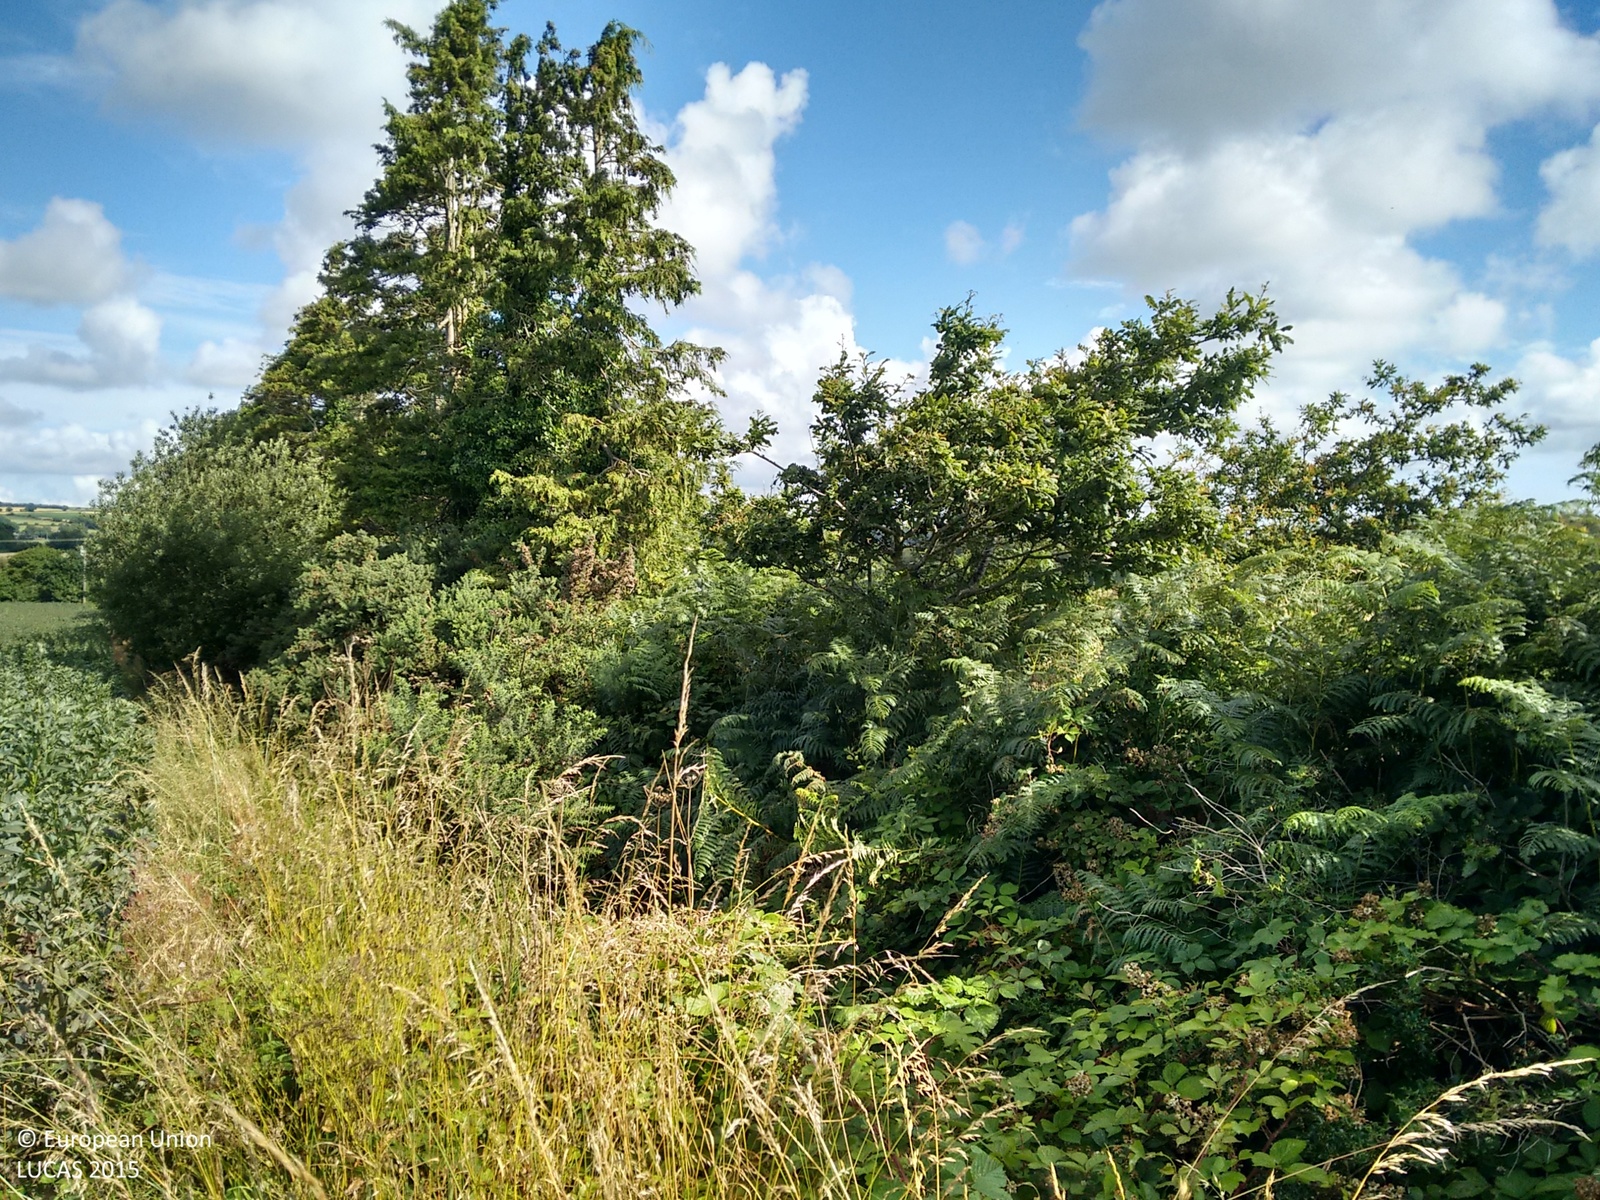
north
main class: Cropland
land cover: Dry pulses
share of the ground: > 75 %
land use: Agriculture (excluding fallow land and kitchen gardens)
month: August
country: IE
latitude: 52.5360
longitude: -6.3554
